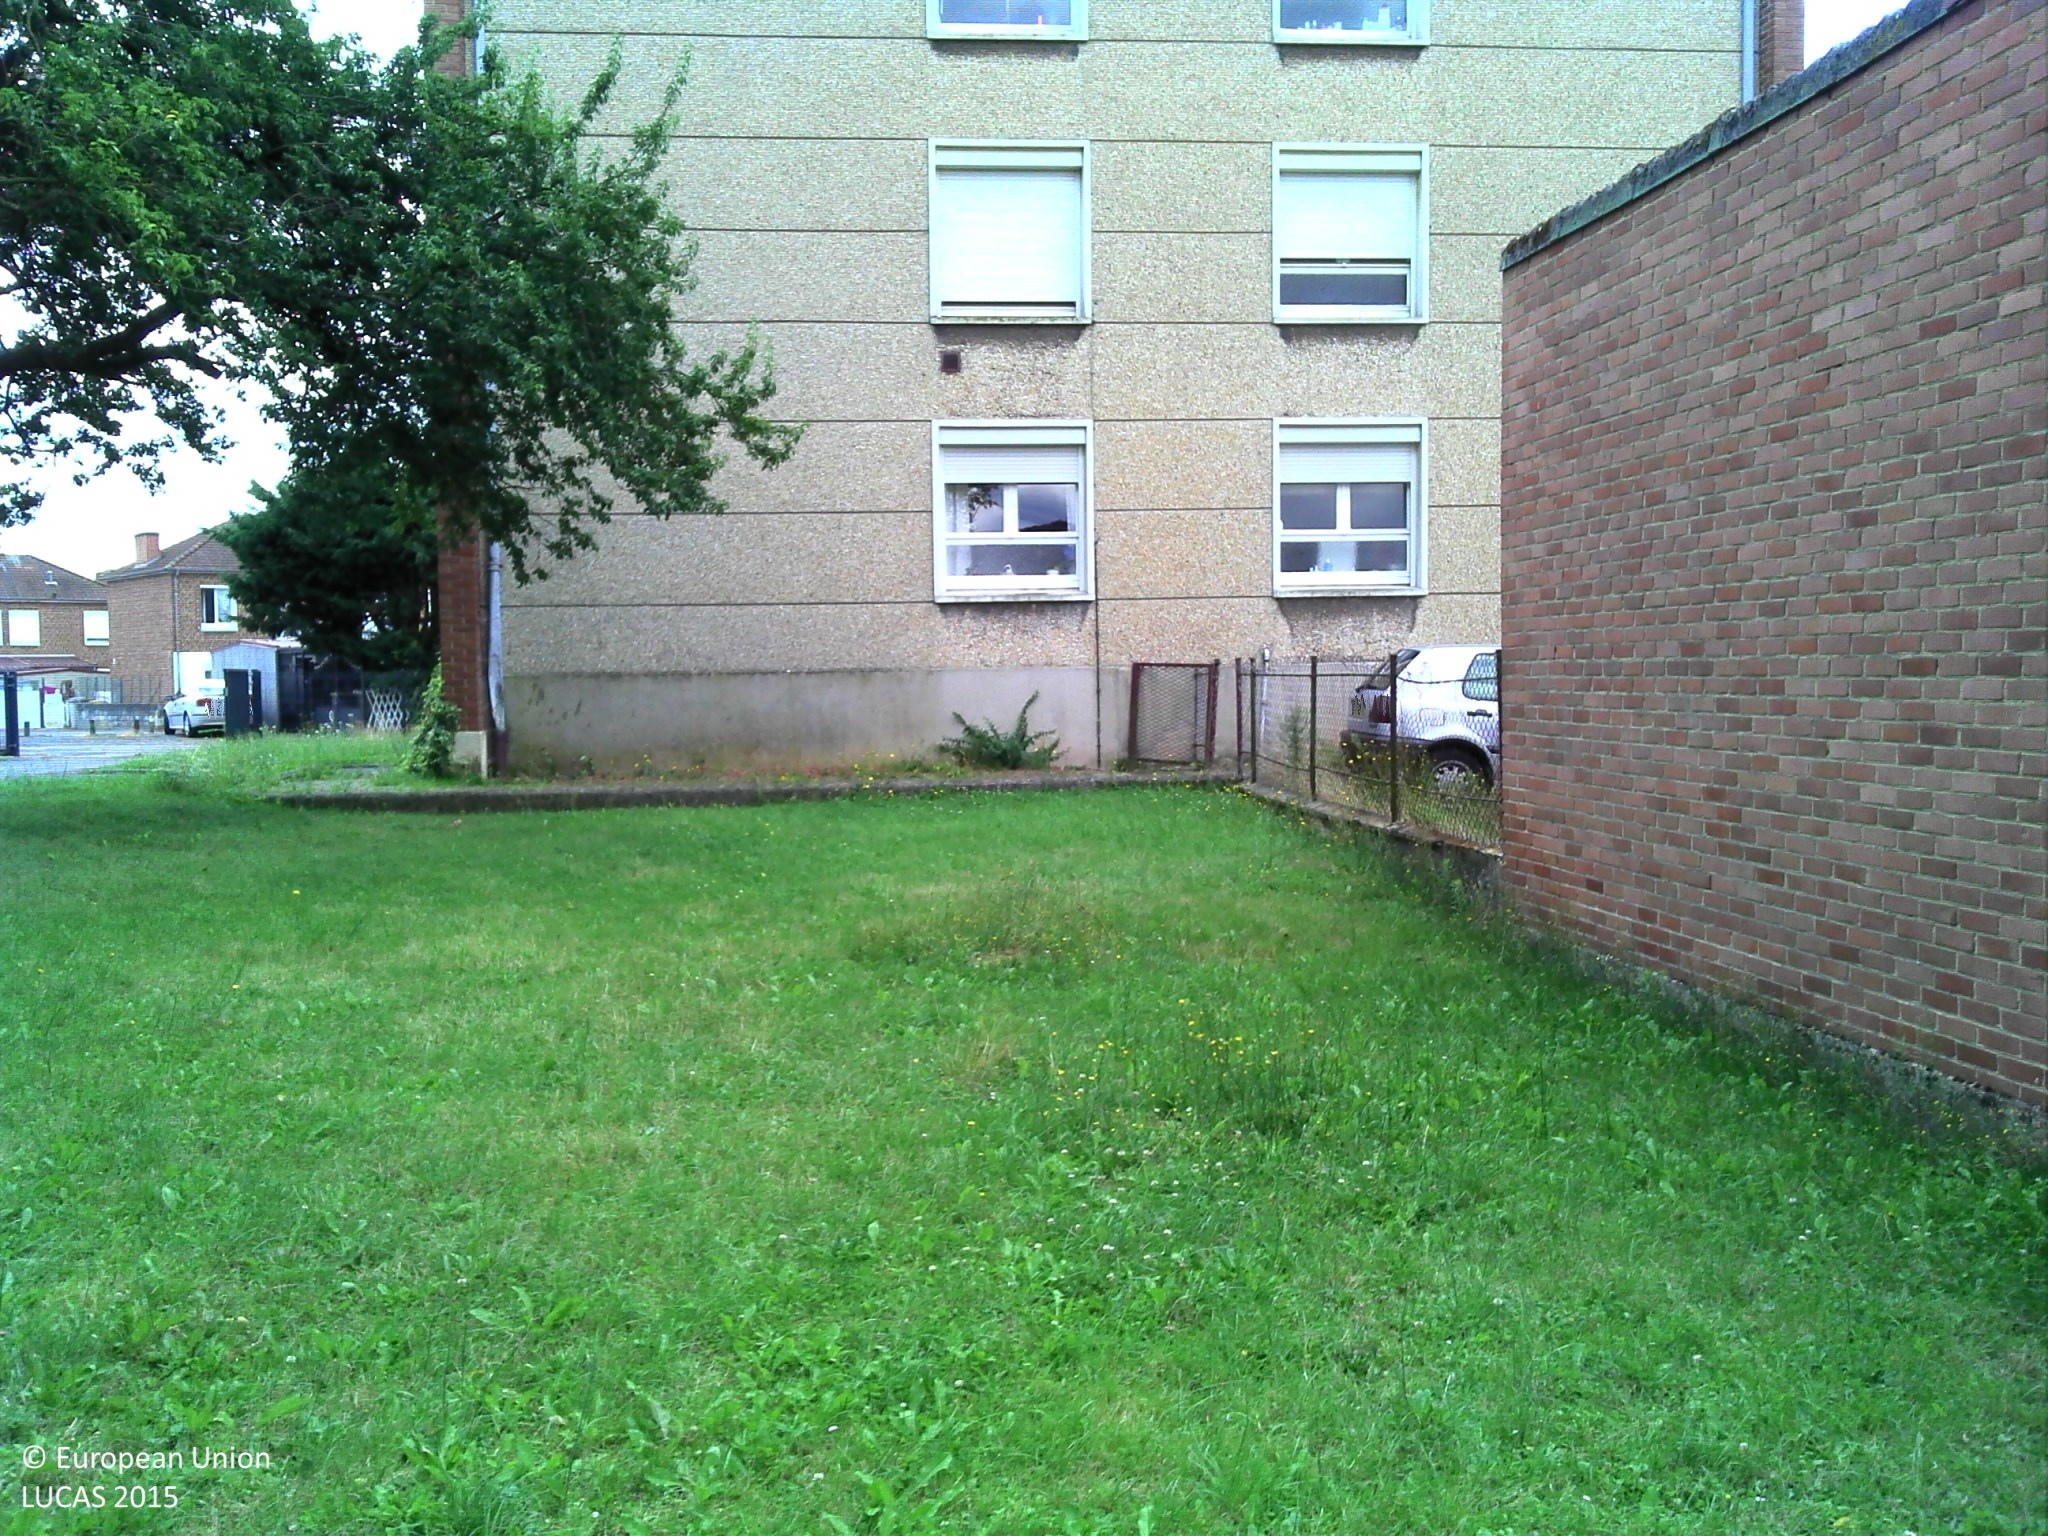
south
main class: Grassland
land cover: Grassland without tree/shrub cover
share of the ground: > 75 %
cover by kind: herbaceous plants 100 %
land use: Community services
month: July
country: FR
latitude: 50.4545
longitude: 3.5841
